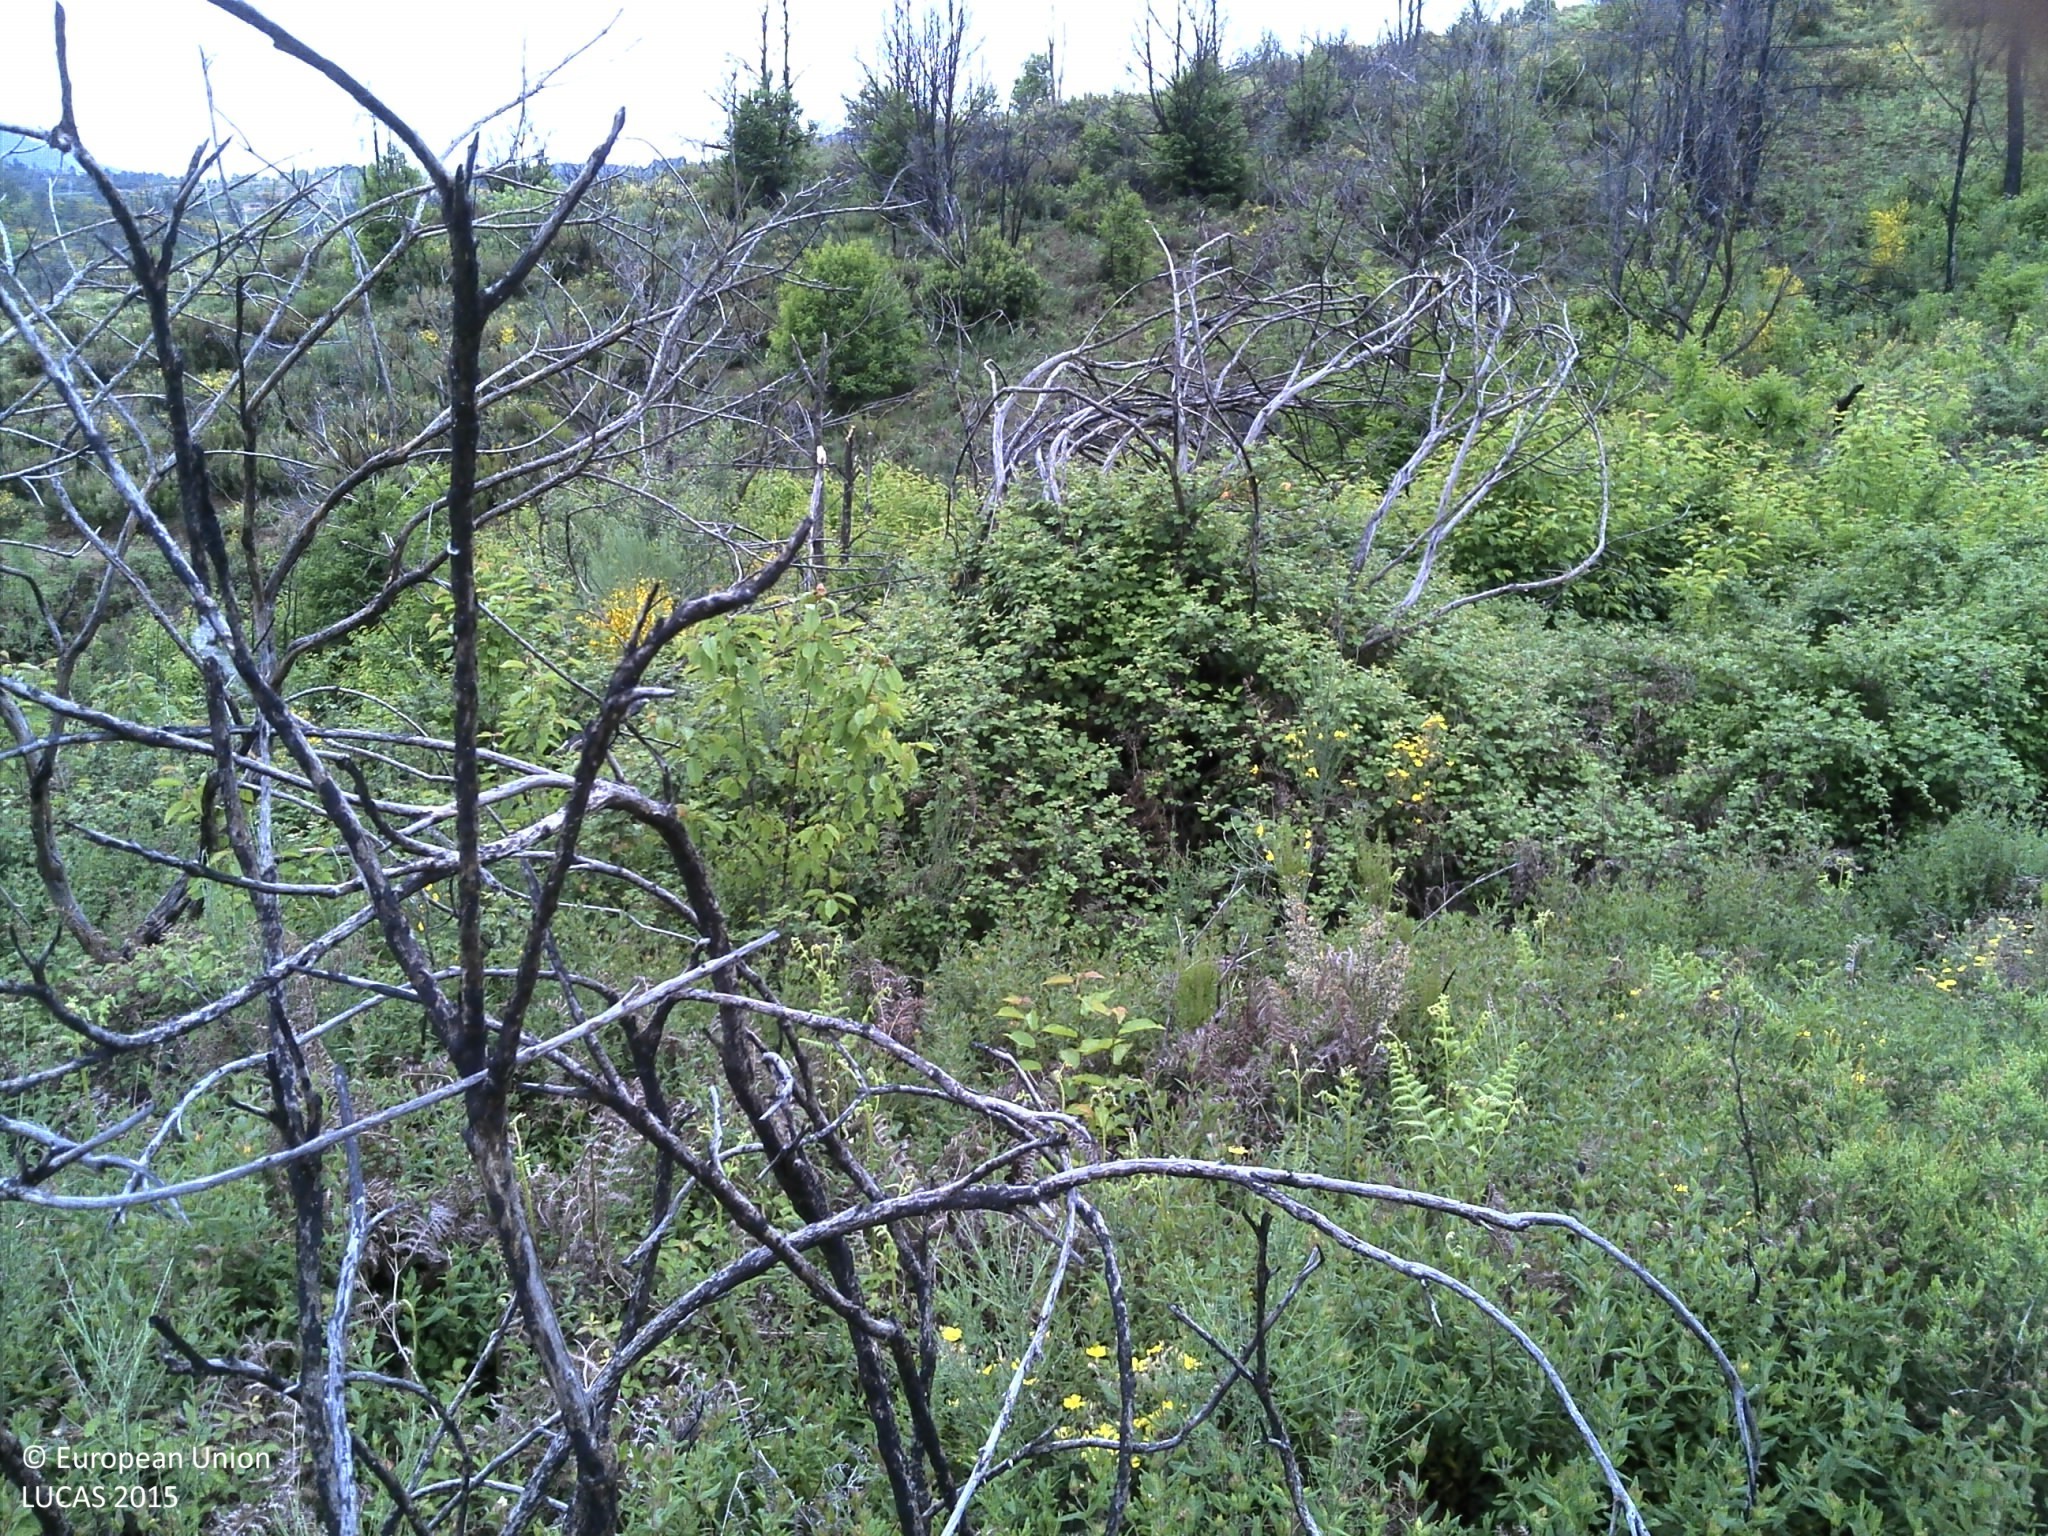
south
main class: Shrubland
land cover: Shrubland with sparse tree cover
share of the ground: 25 - 50 %
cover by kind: shrubs 50 %, unconsolidated bare surface 40 %, broadleaved forest trees 5 %, herbaceous plants 5 %
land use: Forestry
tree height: < 5 m
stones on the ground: 10 - 25 %
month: May
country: PT
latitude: 41.7947
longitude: -7.1017
